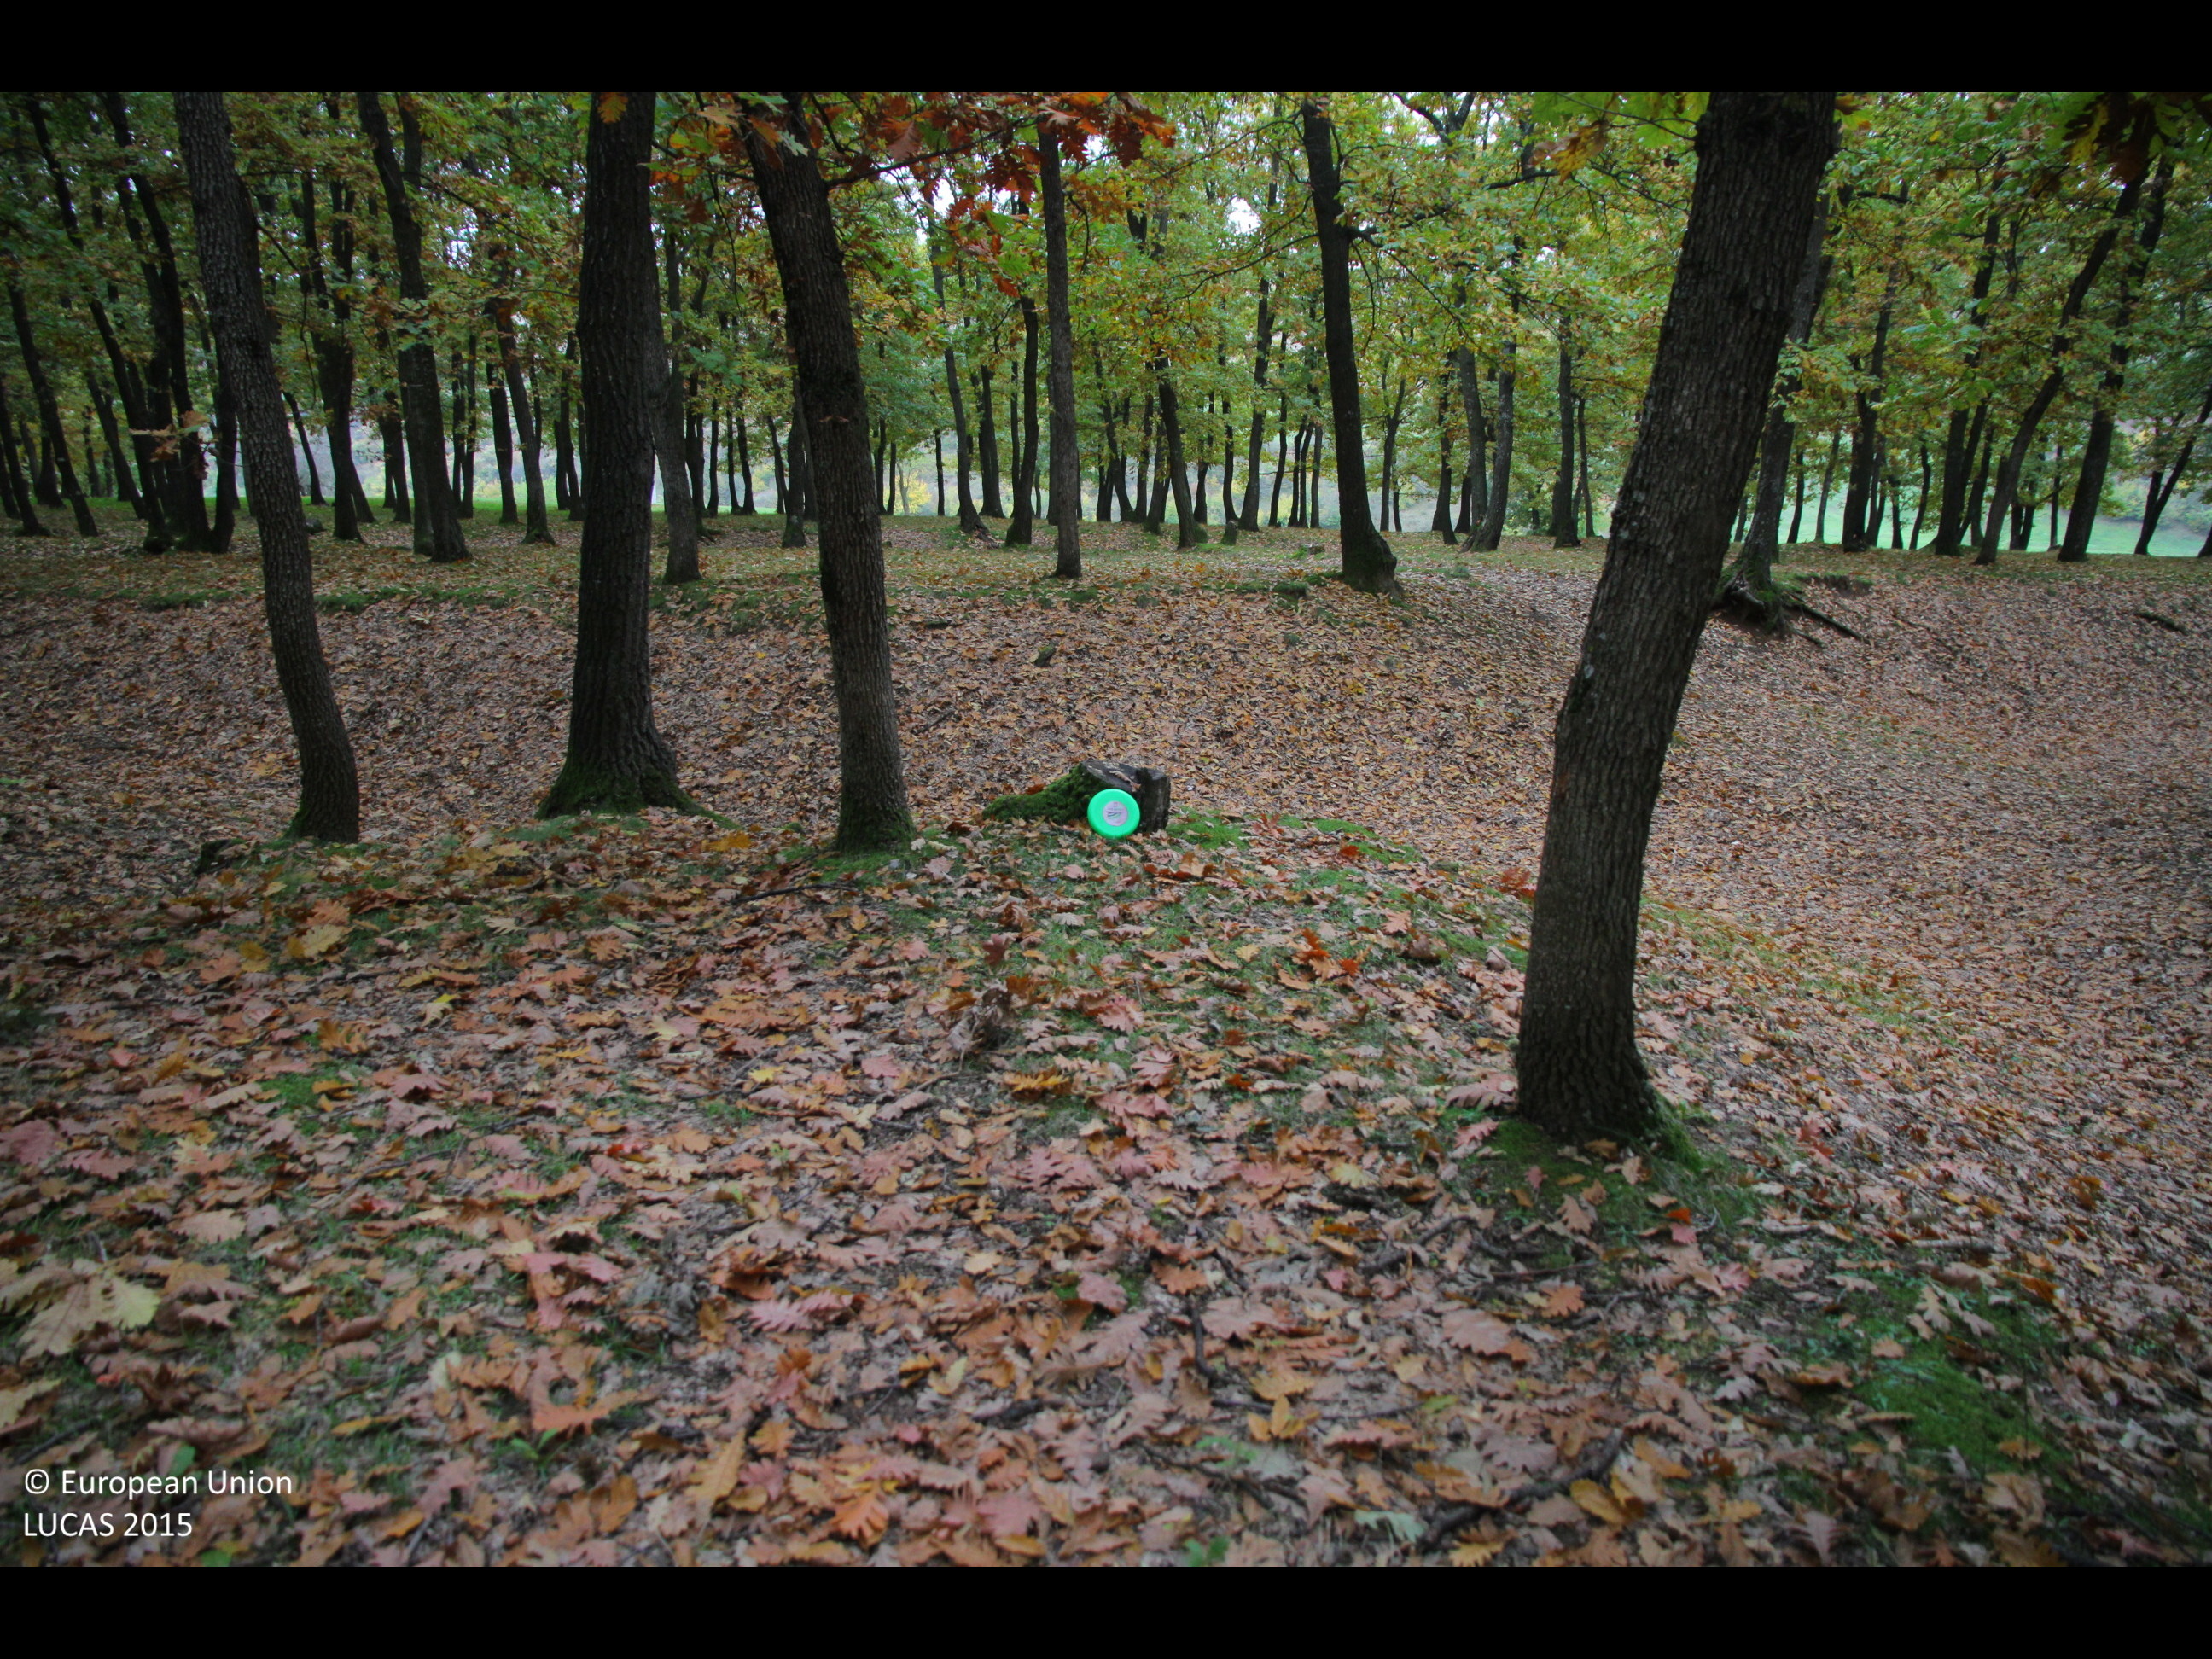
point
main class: Woodland
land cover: Broadleaved woodland
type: mesophytic deciduous forest
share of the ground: > 75 %
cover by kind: broadleaved forest trees 100 %
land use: Forestry
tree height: > 5 m
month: October
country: BG
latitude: 43.4543
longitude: 26.7570
